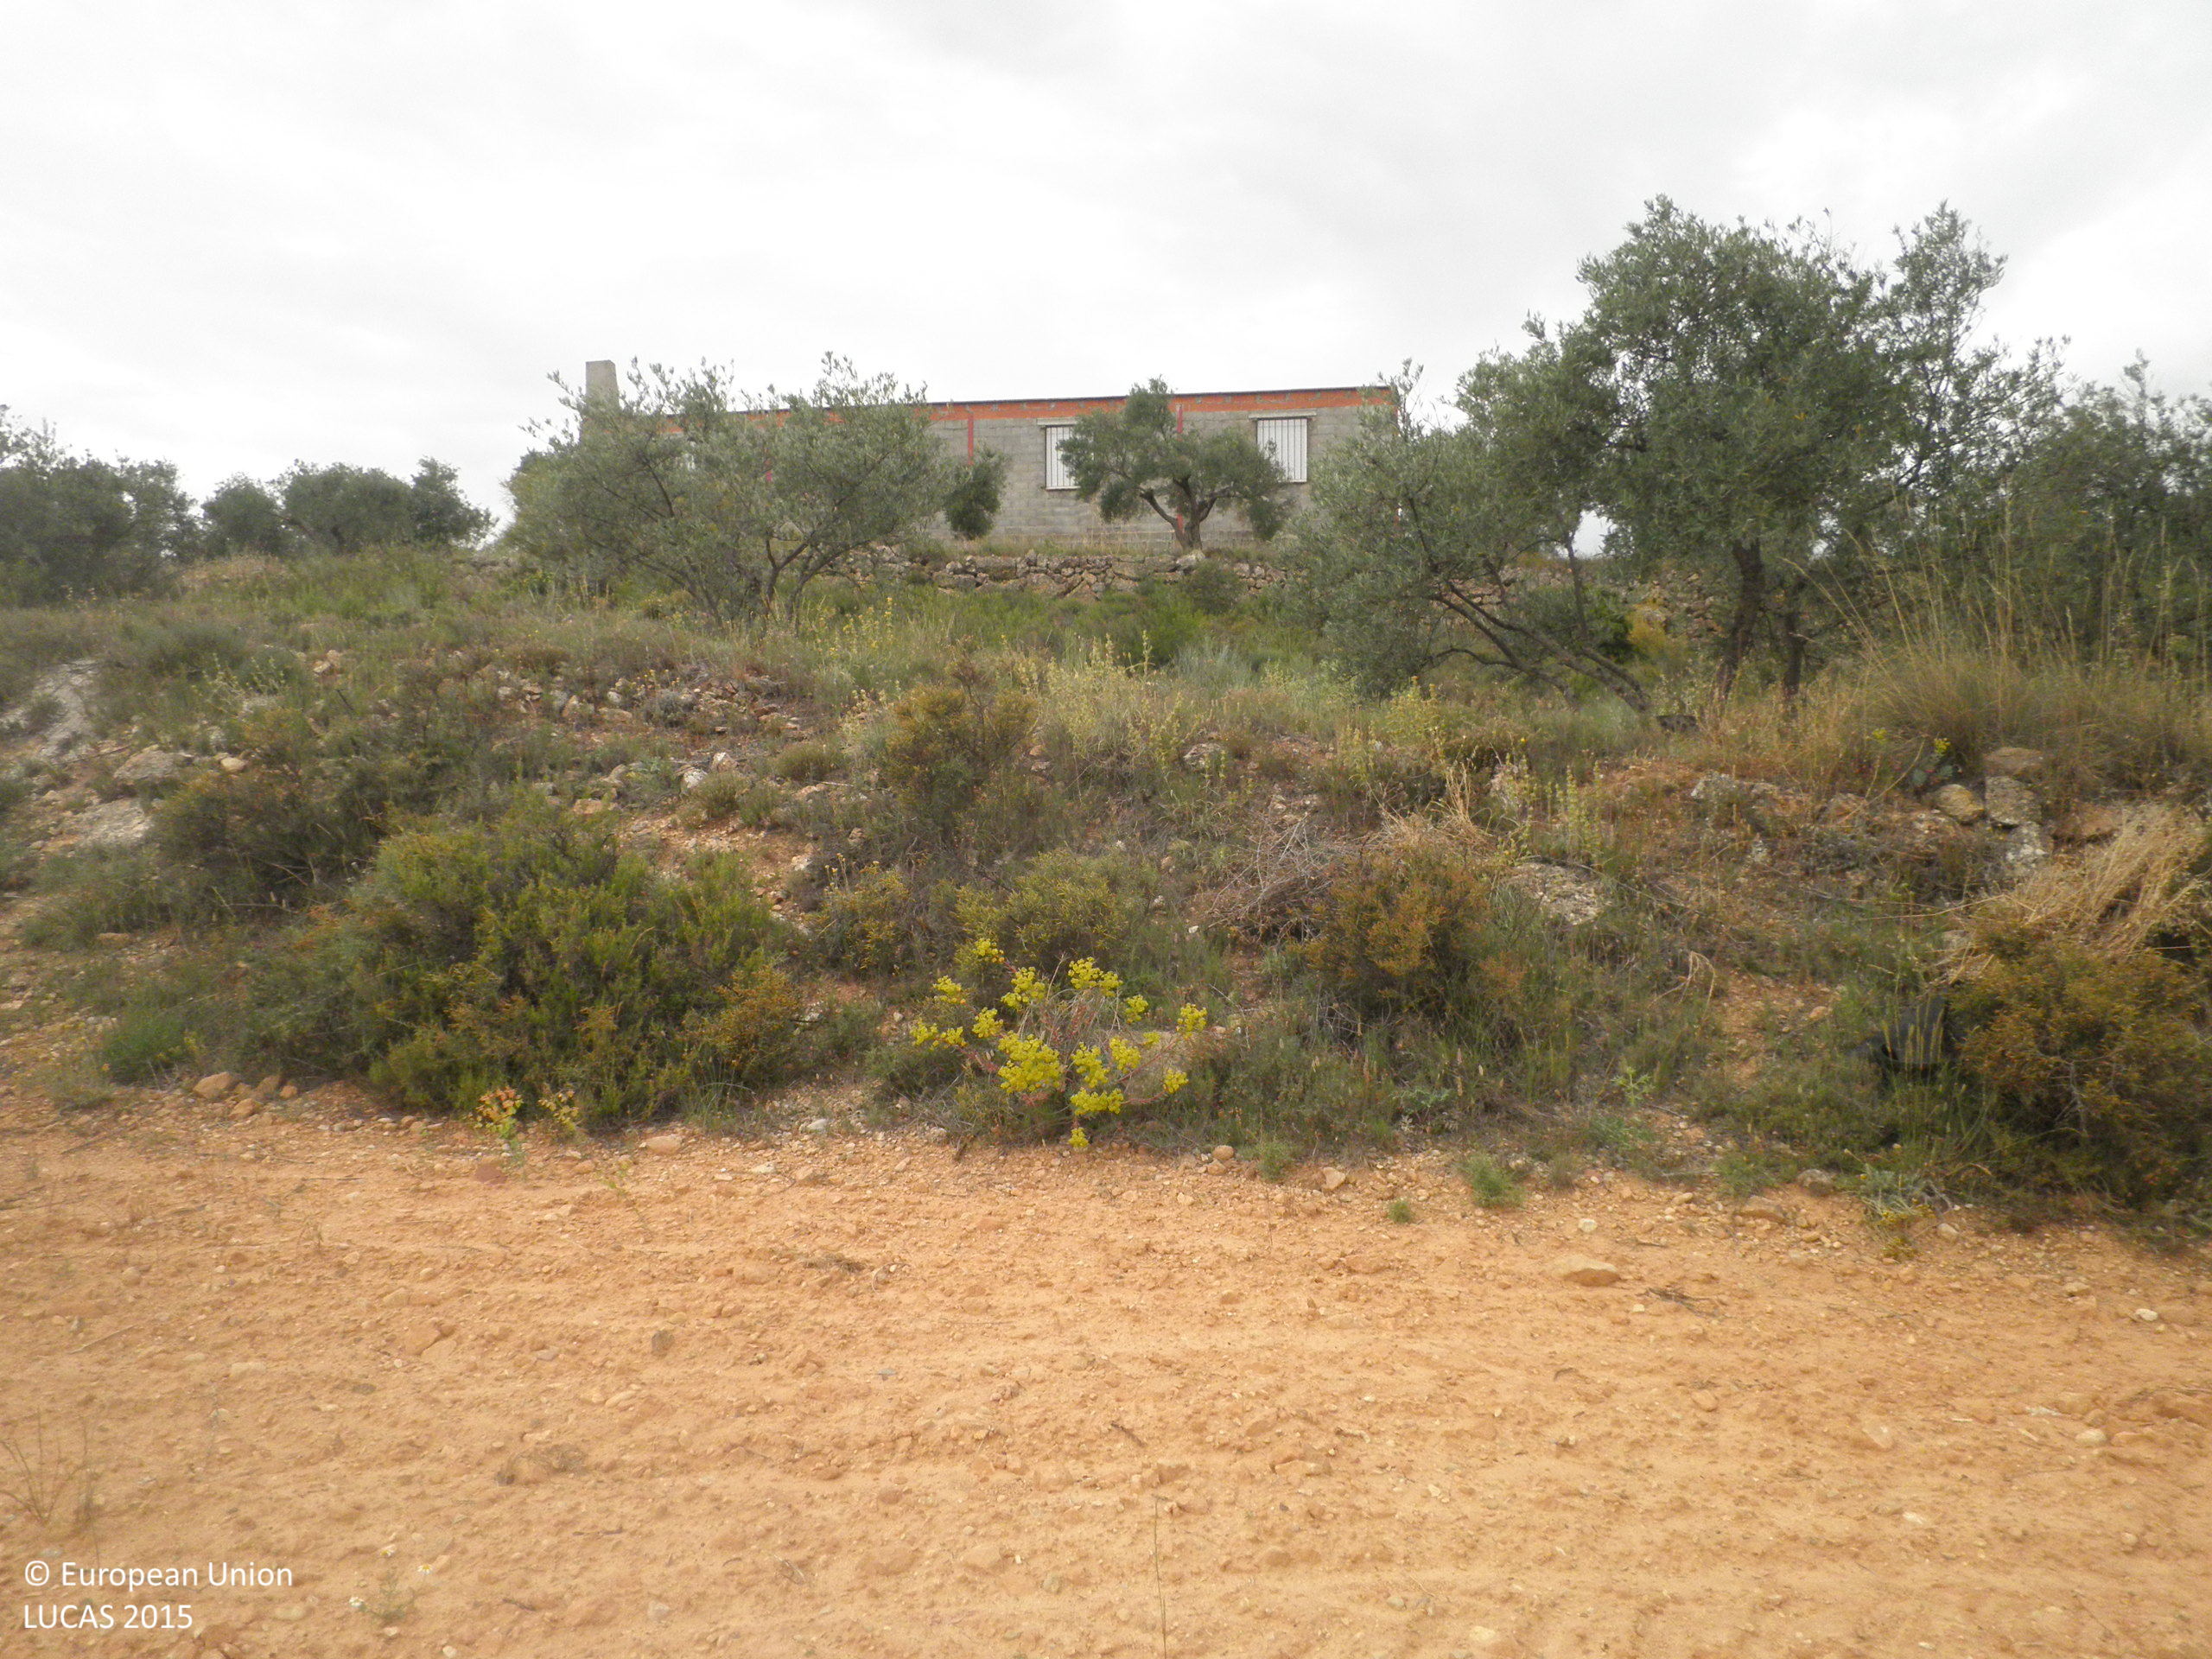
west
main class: Cropland
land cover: Olive groves
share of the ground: < 10 %
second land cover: Spontaneously vegetated surfaces
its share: > 75 %
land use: Agriculture (excluding fallow land and kitchen gardens)
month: June
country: ES
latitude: 39.5781
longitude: -1.5893
